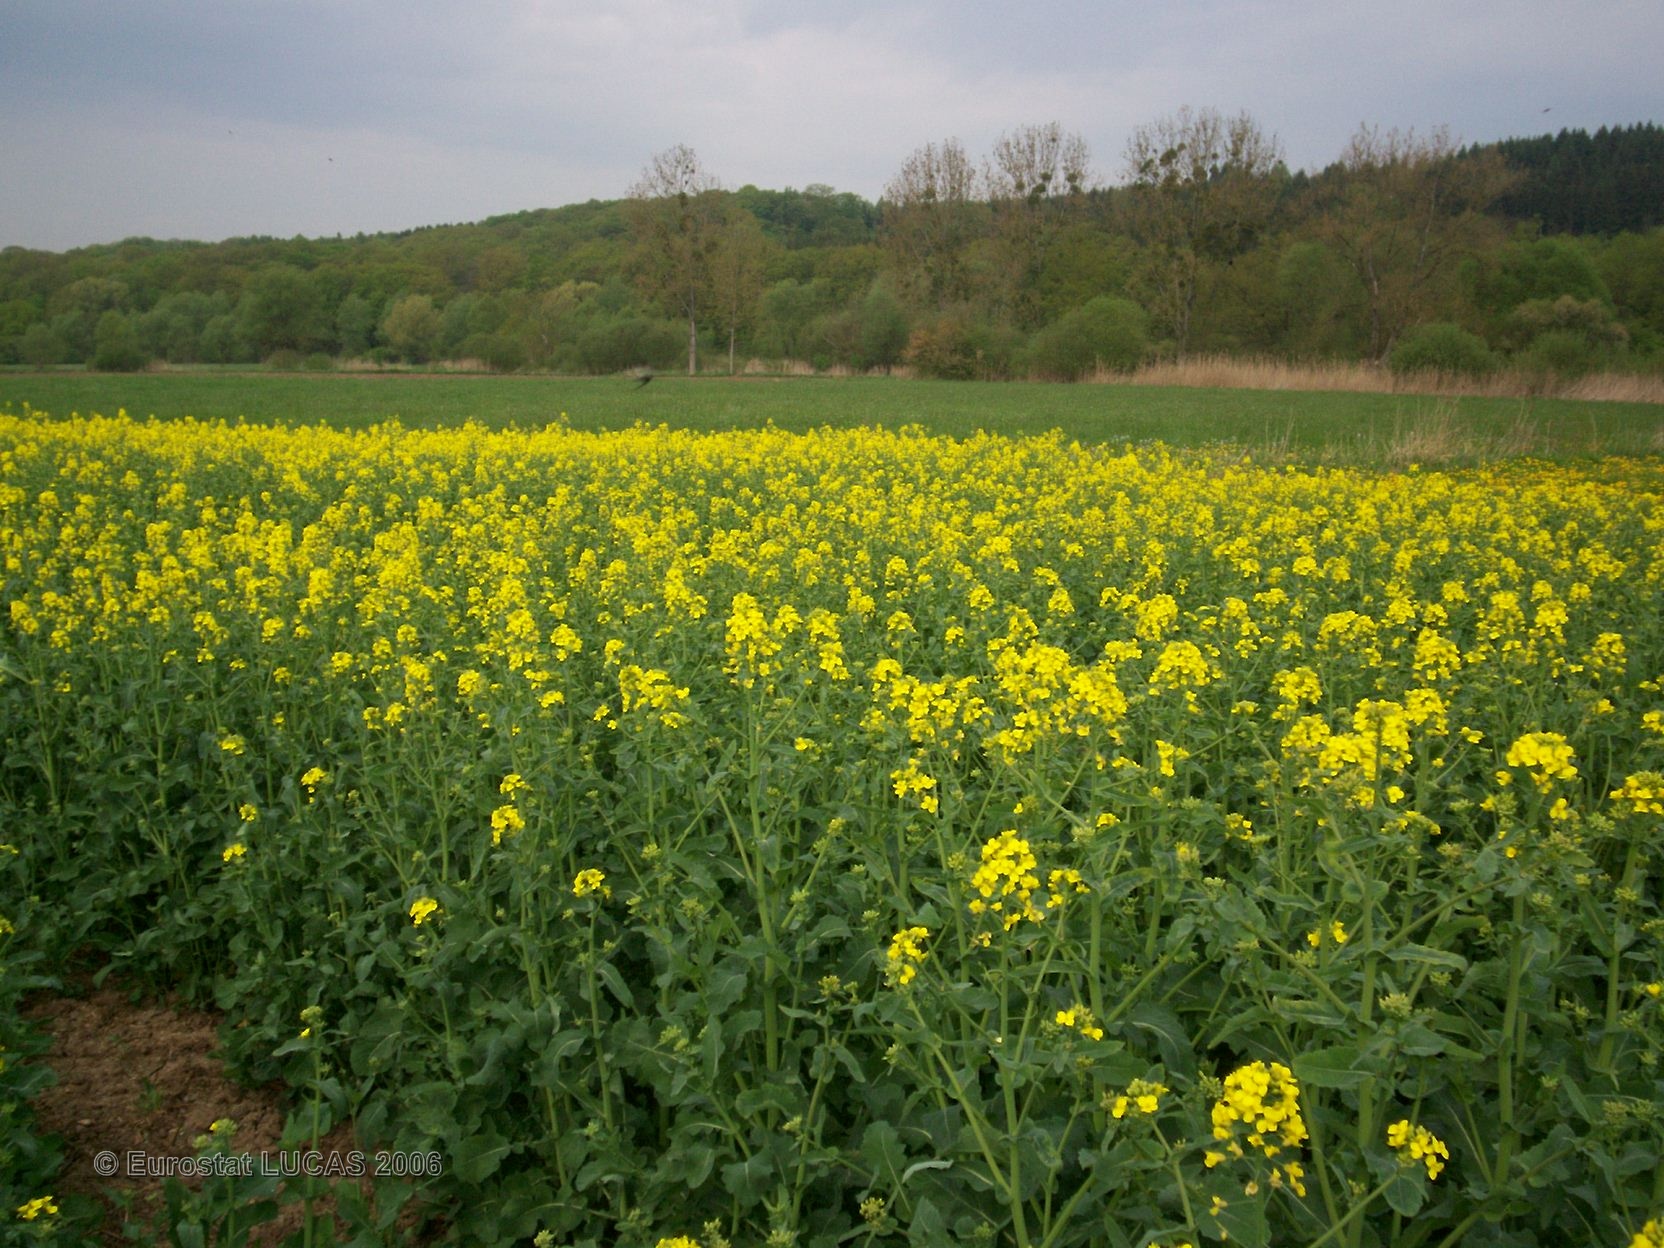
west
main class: Cropland
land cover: Rape and turnip rape
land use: Agriculture (excluding fallow land and kitchen gardens)
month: May
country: FR
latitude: 49.1560
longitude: 6.4212
